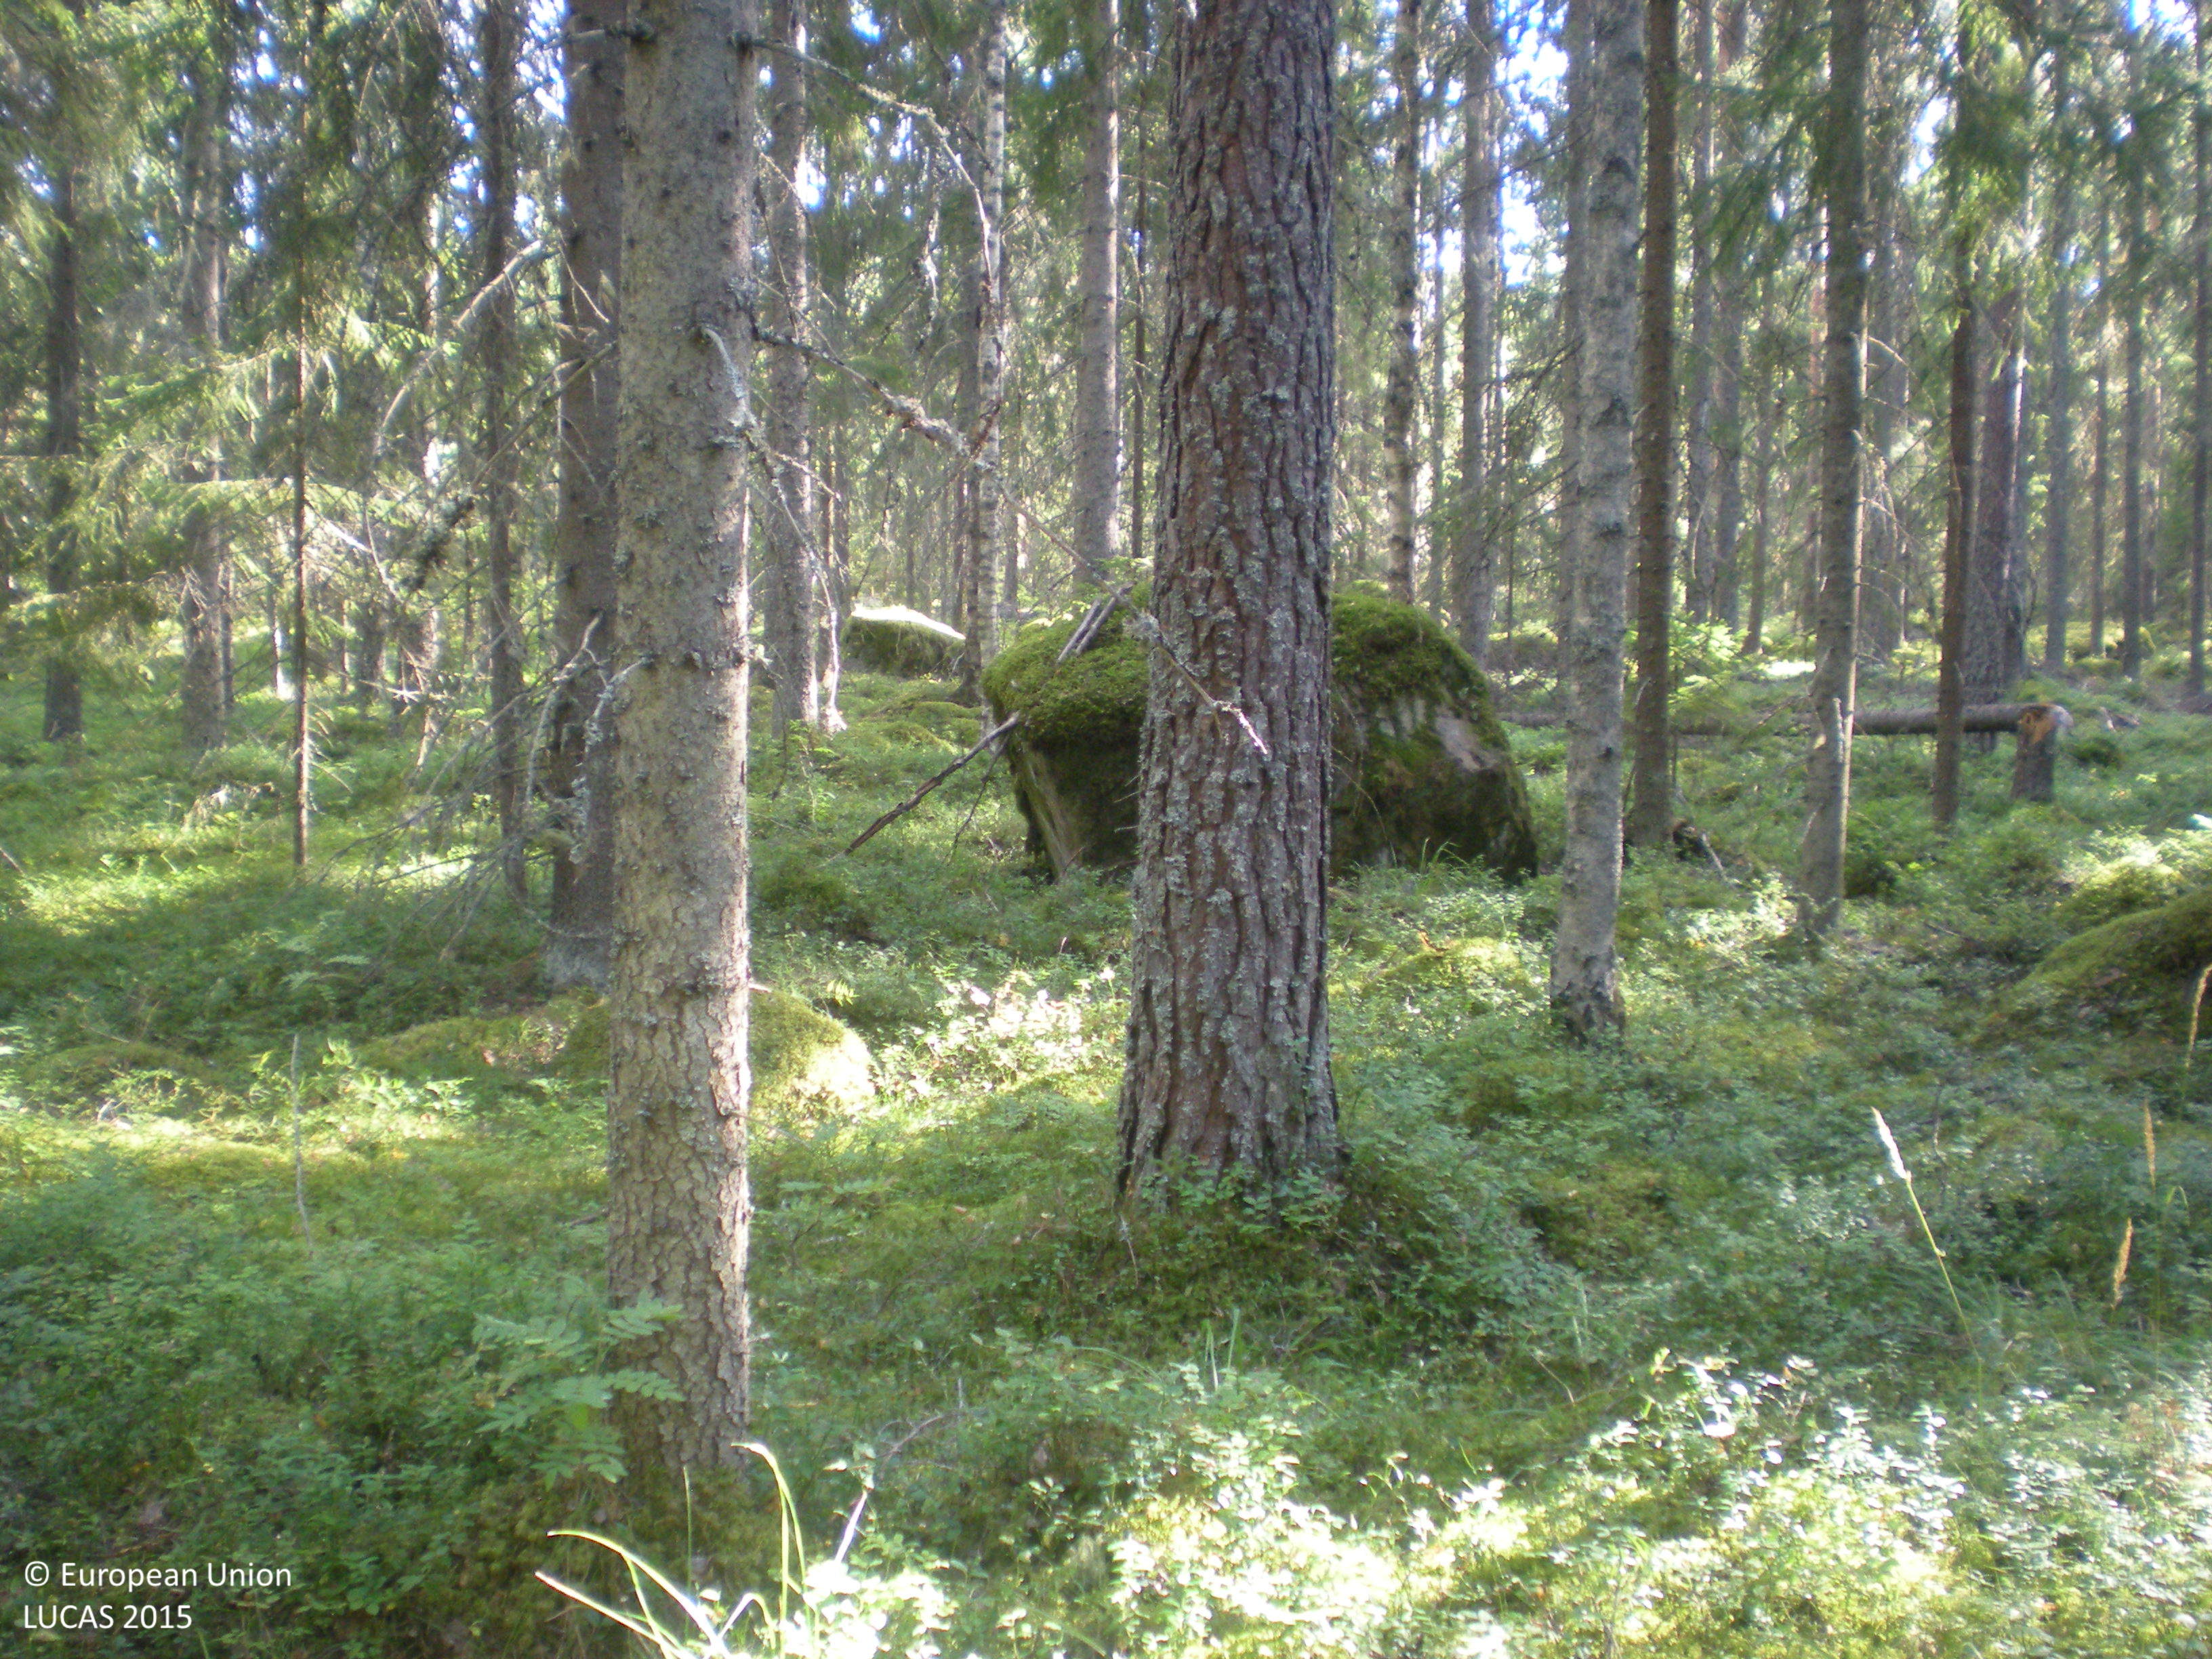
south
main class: Woodland
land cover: Spruce dominated coniferous woodland
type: boreal forest
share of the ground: 50 - 75 %
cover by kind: coniferous forest trees 60 %, broadleaved forest trees 15 %, shrubs 15 %, herbaceous plants 5 %, lichens and mosses 5 %
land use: Forestry
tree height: > 5 m
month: August
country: SE
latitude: 60.5125
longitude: 16.6363
